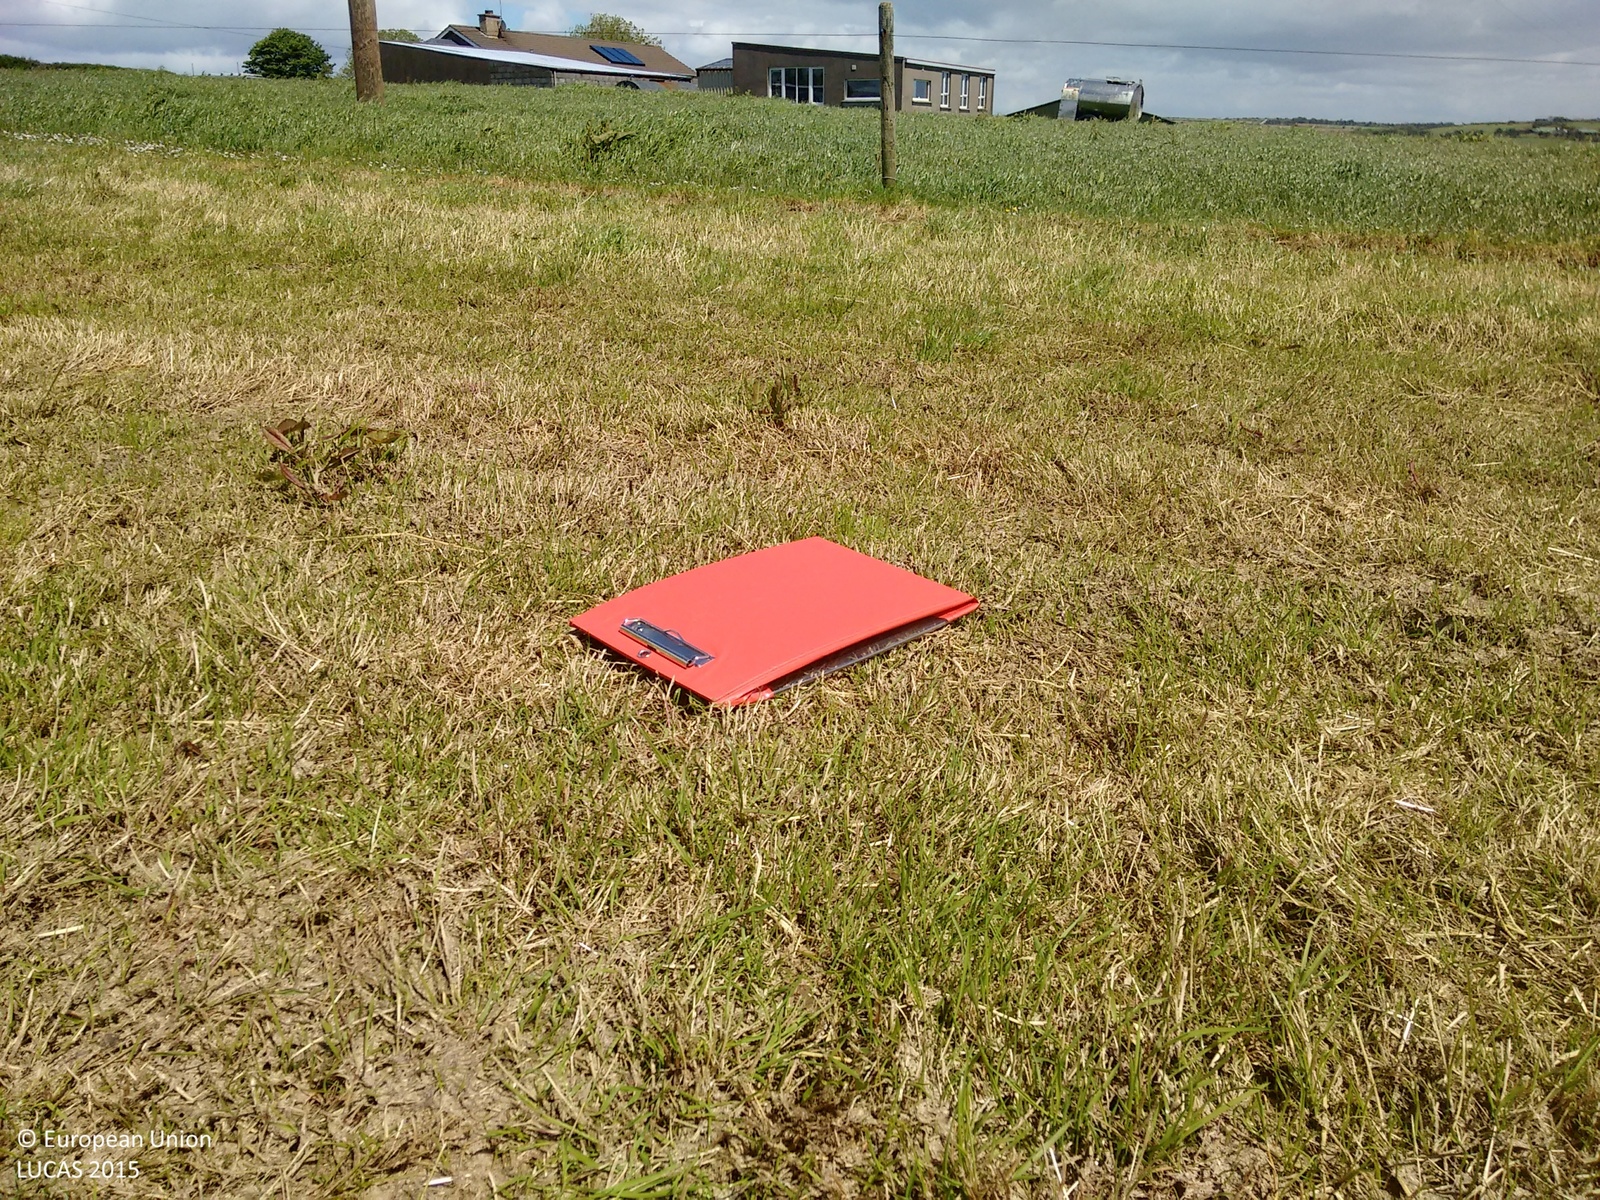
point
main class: Grassland
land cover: Grassland without tree/shrub cover
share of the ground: > 75 %
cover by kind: herbaceous plants 80 %, unconsolidated bare surface 20 %
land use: Agriculture (excluding fallow land and kitchen gardens)
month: June
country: IE
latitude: 51.6673
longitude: -8.6937
